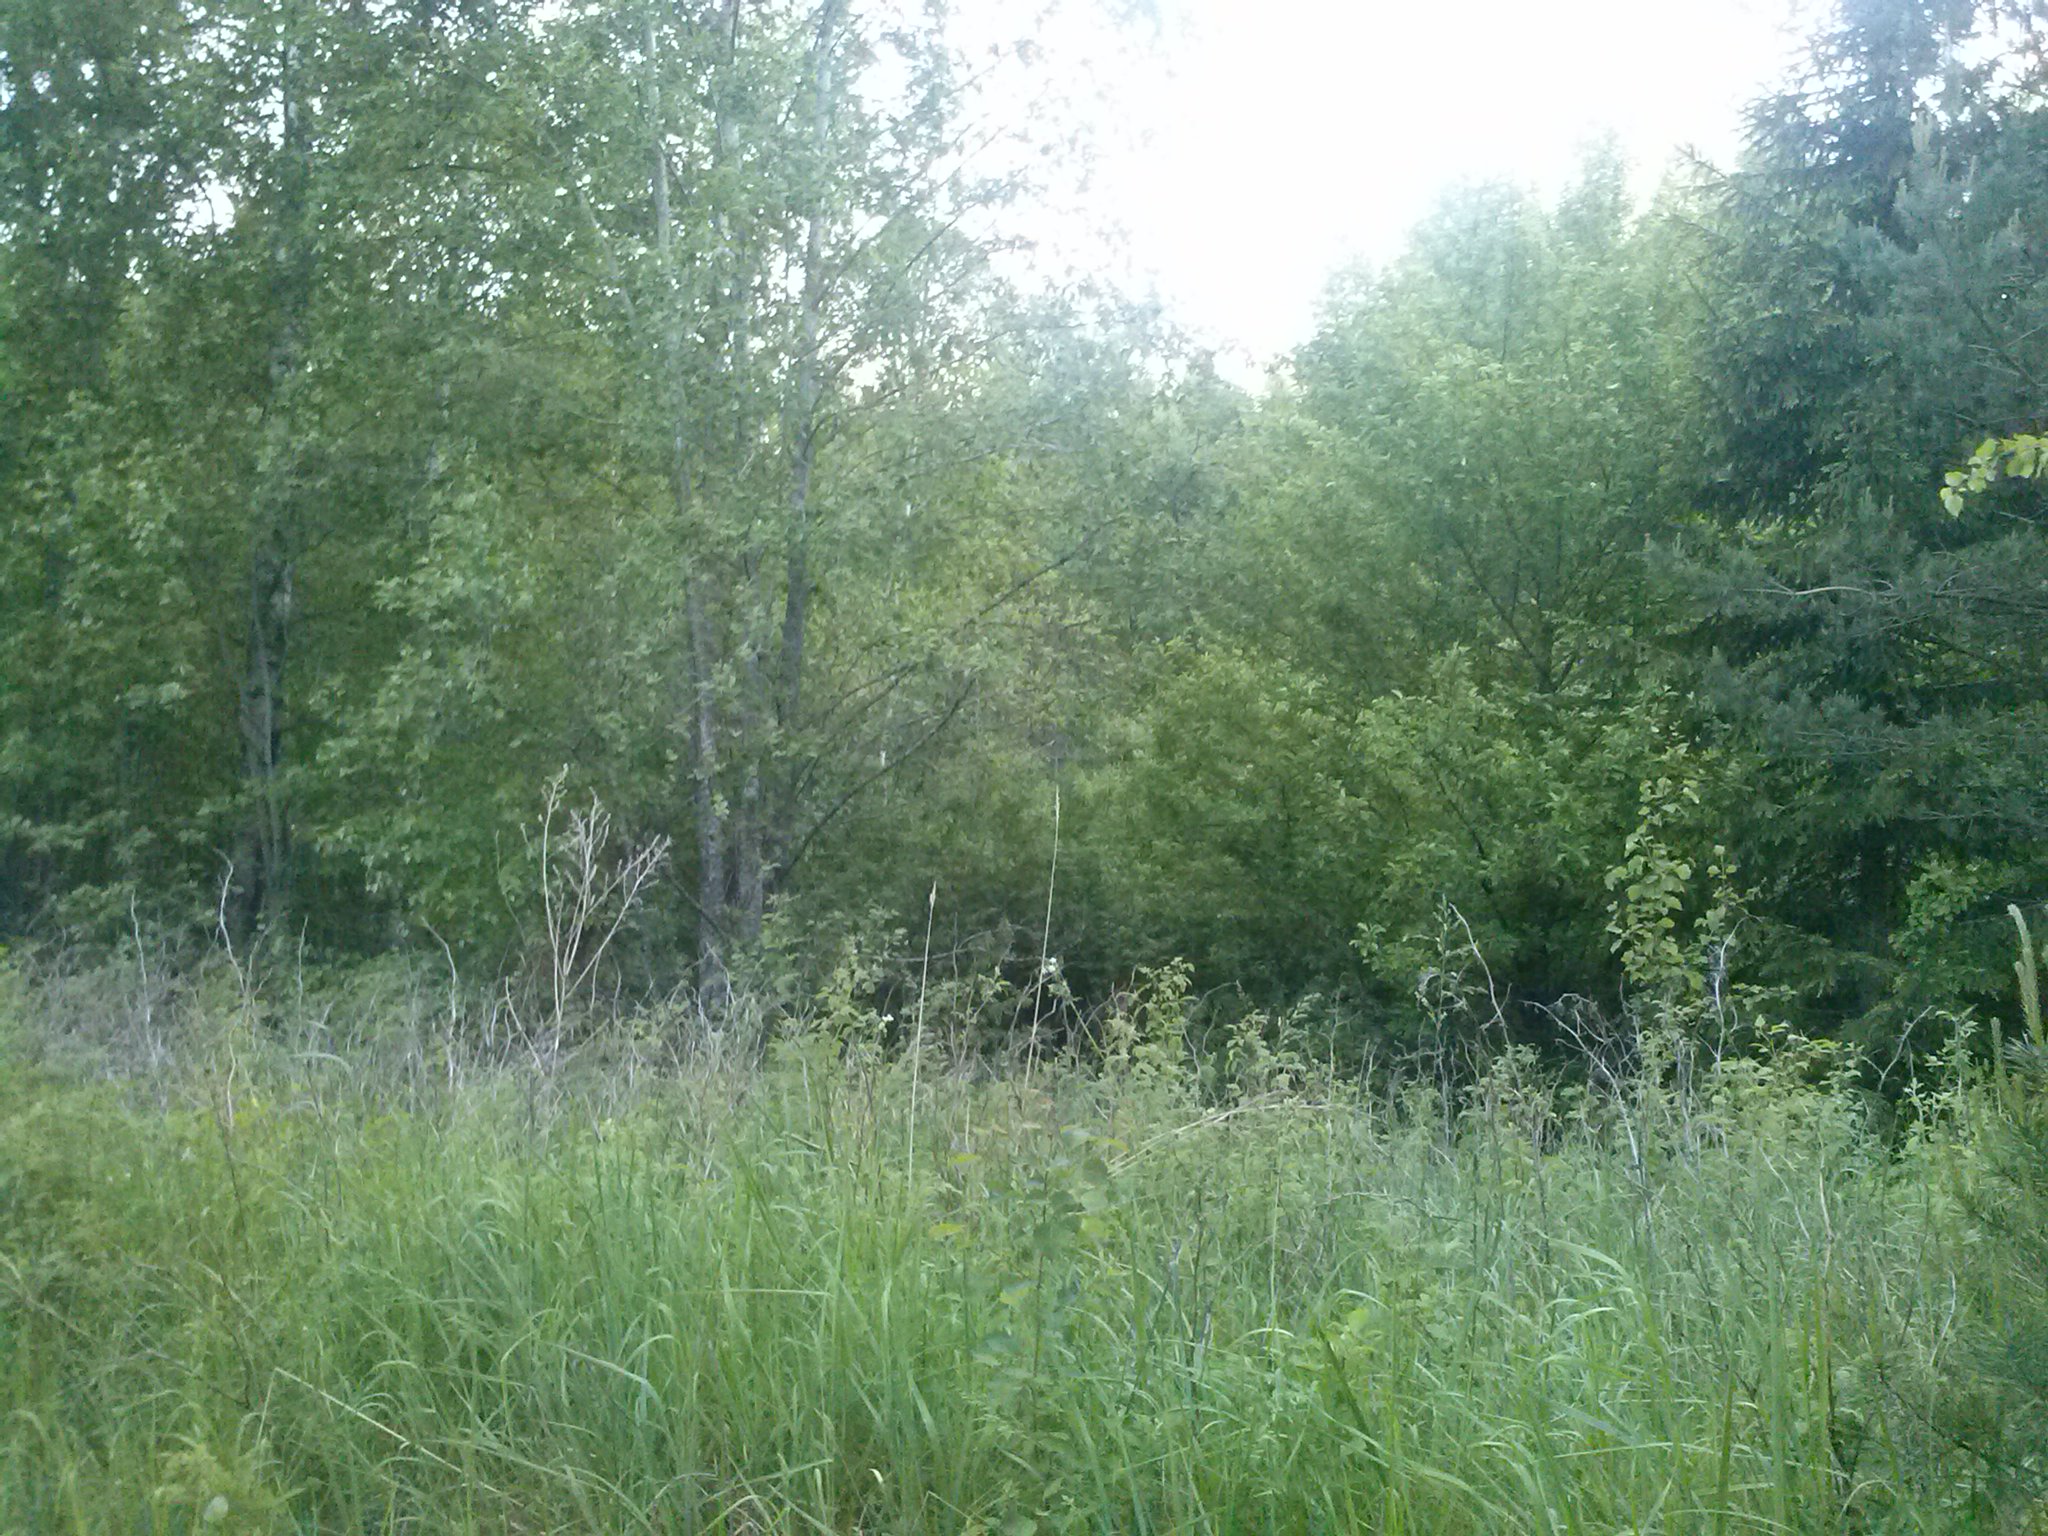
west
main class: Woodland
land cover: Pine dominated mixed woodland
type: hemiboreal forest and nemoral coniferous forest and mixed broadleaved-coniferous forest
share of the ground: > 75 %
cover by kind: coniferous forest trees 60 %, broadleaved forest trees 40 %
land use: Forestry
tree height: > 5 m
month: June
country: LV
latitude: 56.4177
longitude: 27.8443
